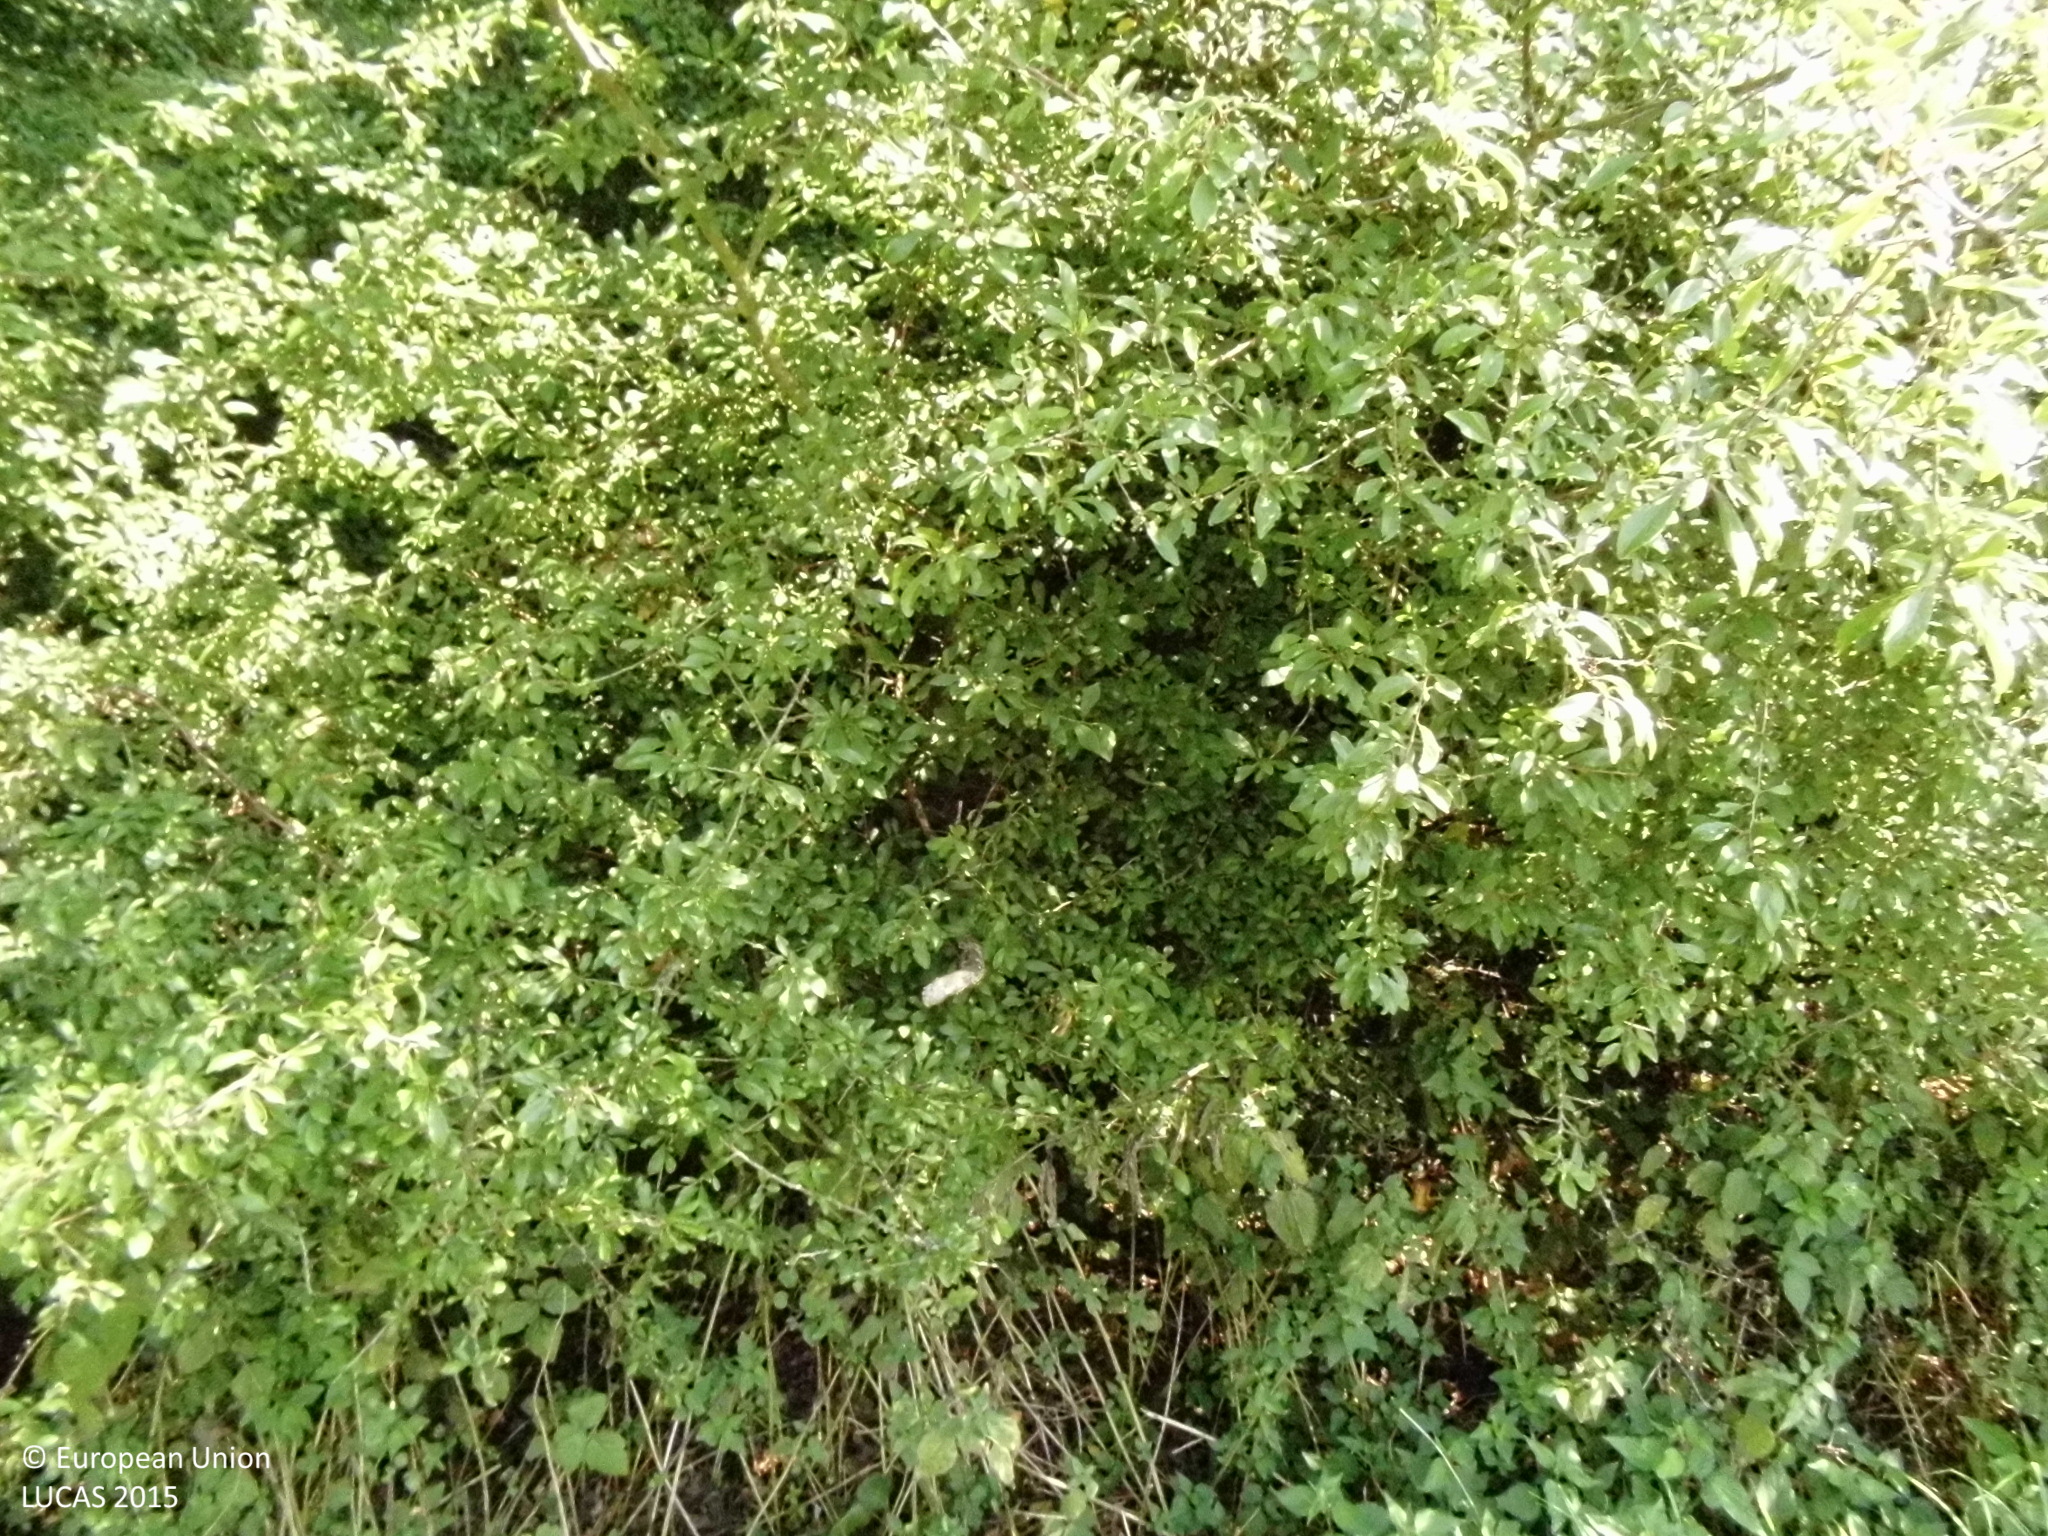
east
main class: Woodland
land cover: Broadleaved woodland
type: mesophytic deciduous forest
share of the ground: > 75 %
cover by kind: broadleaved forest trees 100 %
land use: Forestry
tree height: > 5 m
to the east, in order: Broadleaved woodland; Spruce dominated mixed woodland; Broadleaved woodland
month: August
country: DE
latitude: 50.5645
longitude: 8.1227
